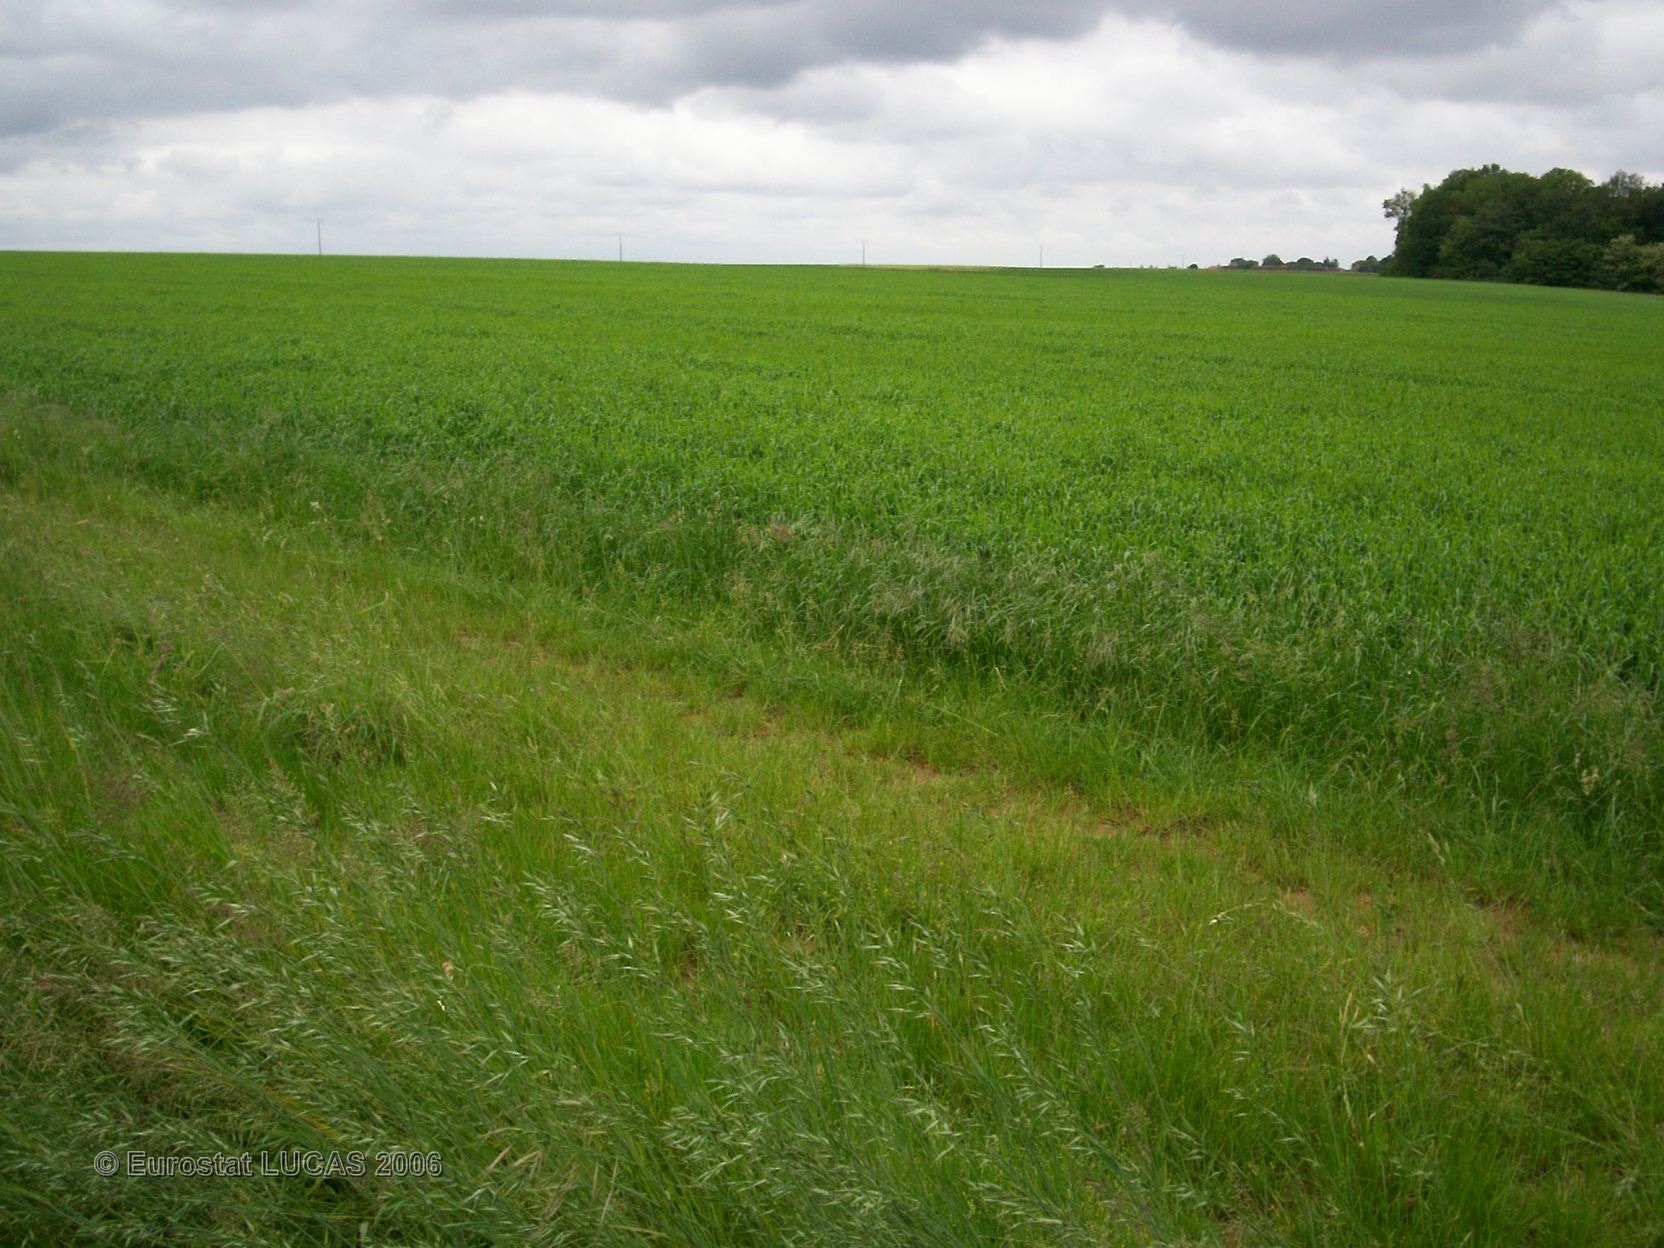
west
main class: Cropland
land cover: Barley
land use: Agriculture (excluding fallow land and kitchen gardens)
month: May
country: FR
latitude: 48.2149
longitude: 4.5471
